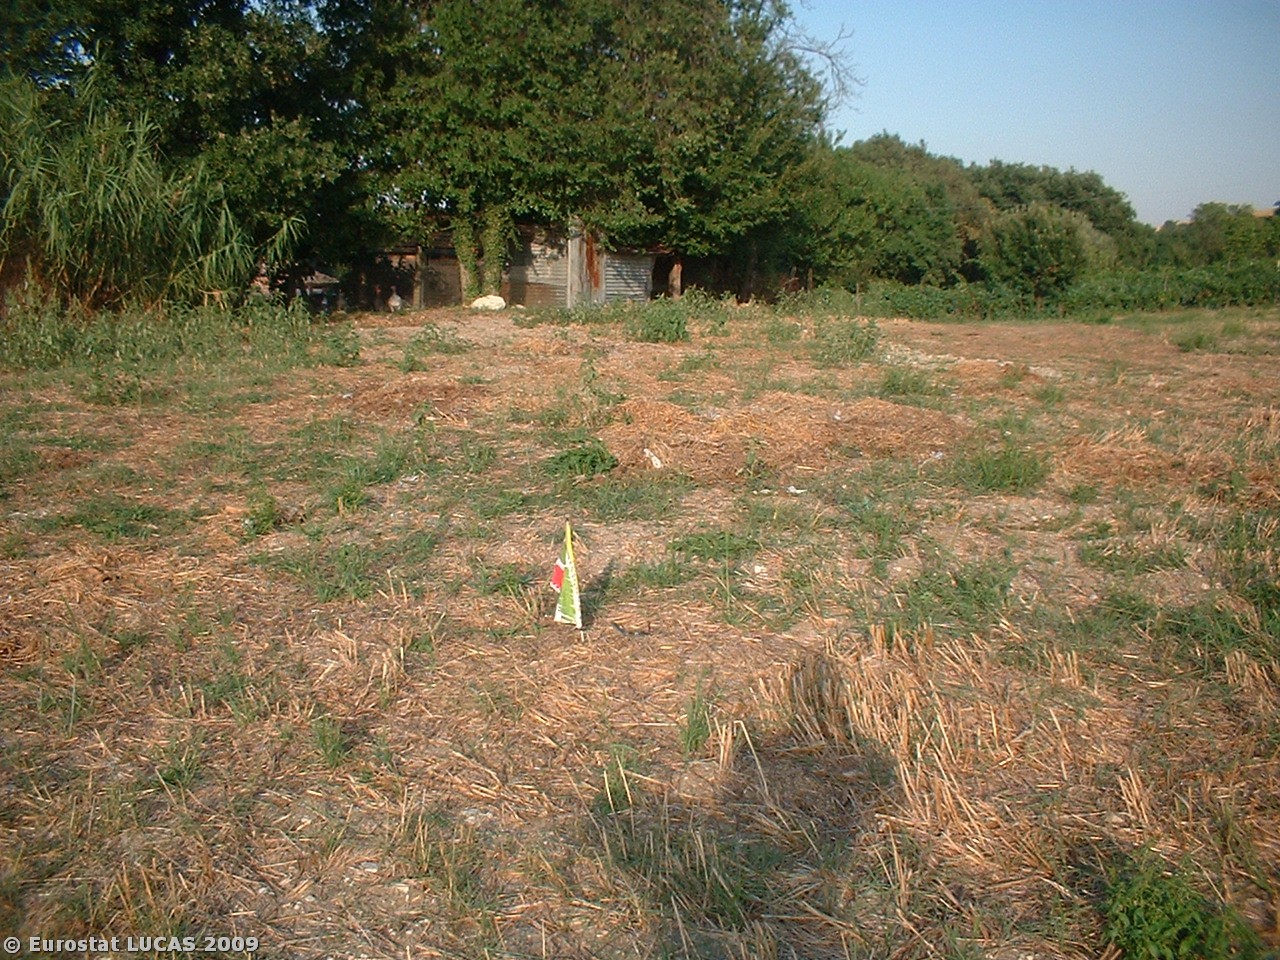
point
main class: Cropland
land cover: Durum wheat
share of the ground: < 10 %
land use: Agriculture (excluding fallow land and kitchen gardens)
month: August
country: IT
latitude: 43.5879
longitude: 12.9033
